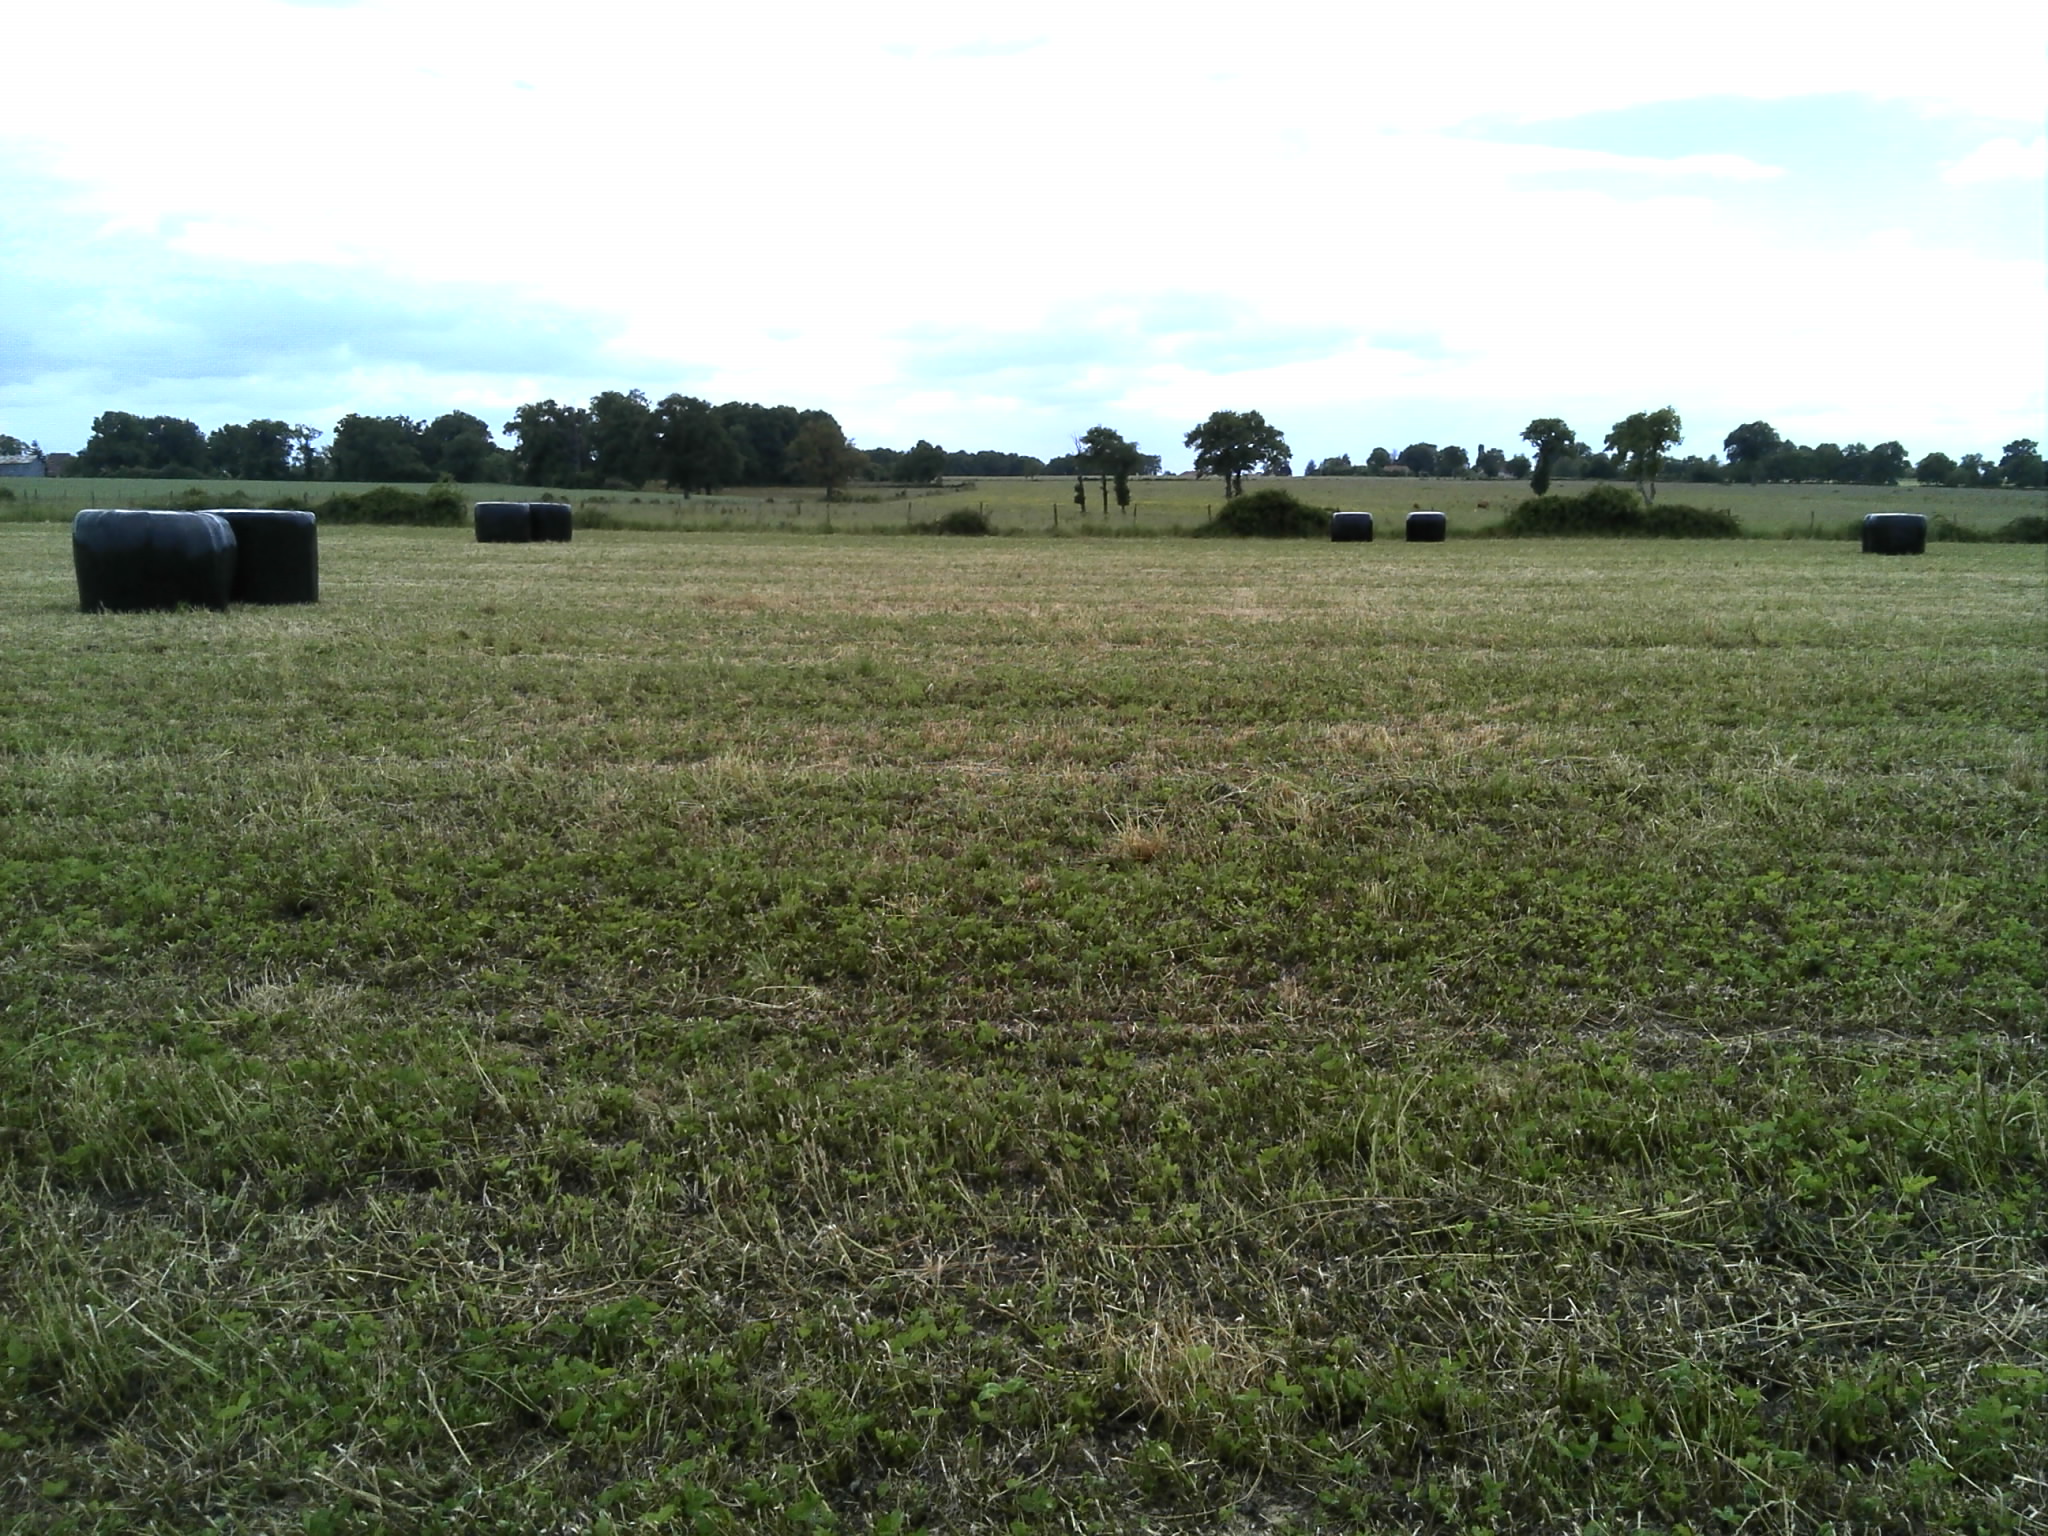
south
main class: Cropland
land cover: Clovers
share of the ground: > 75 %
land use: Agriculture (excluding fallow land and kitchen gardens)
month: May
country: FR
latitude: 46.5375
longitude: 1.5010
